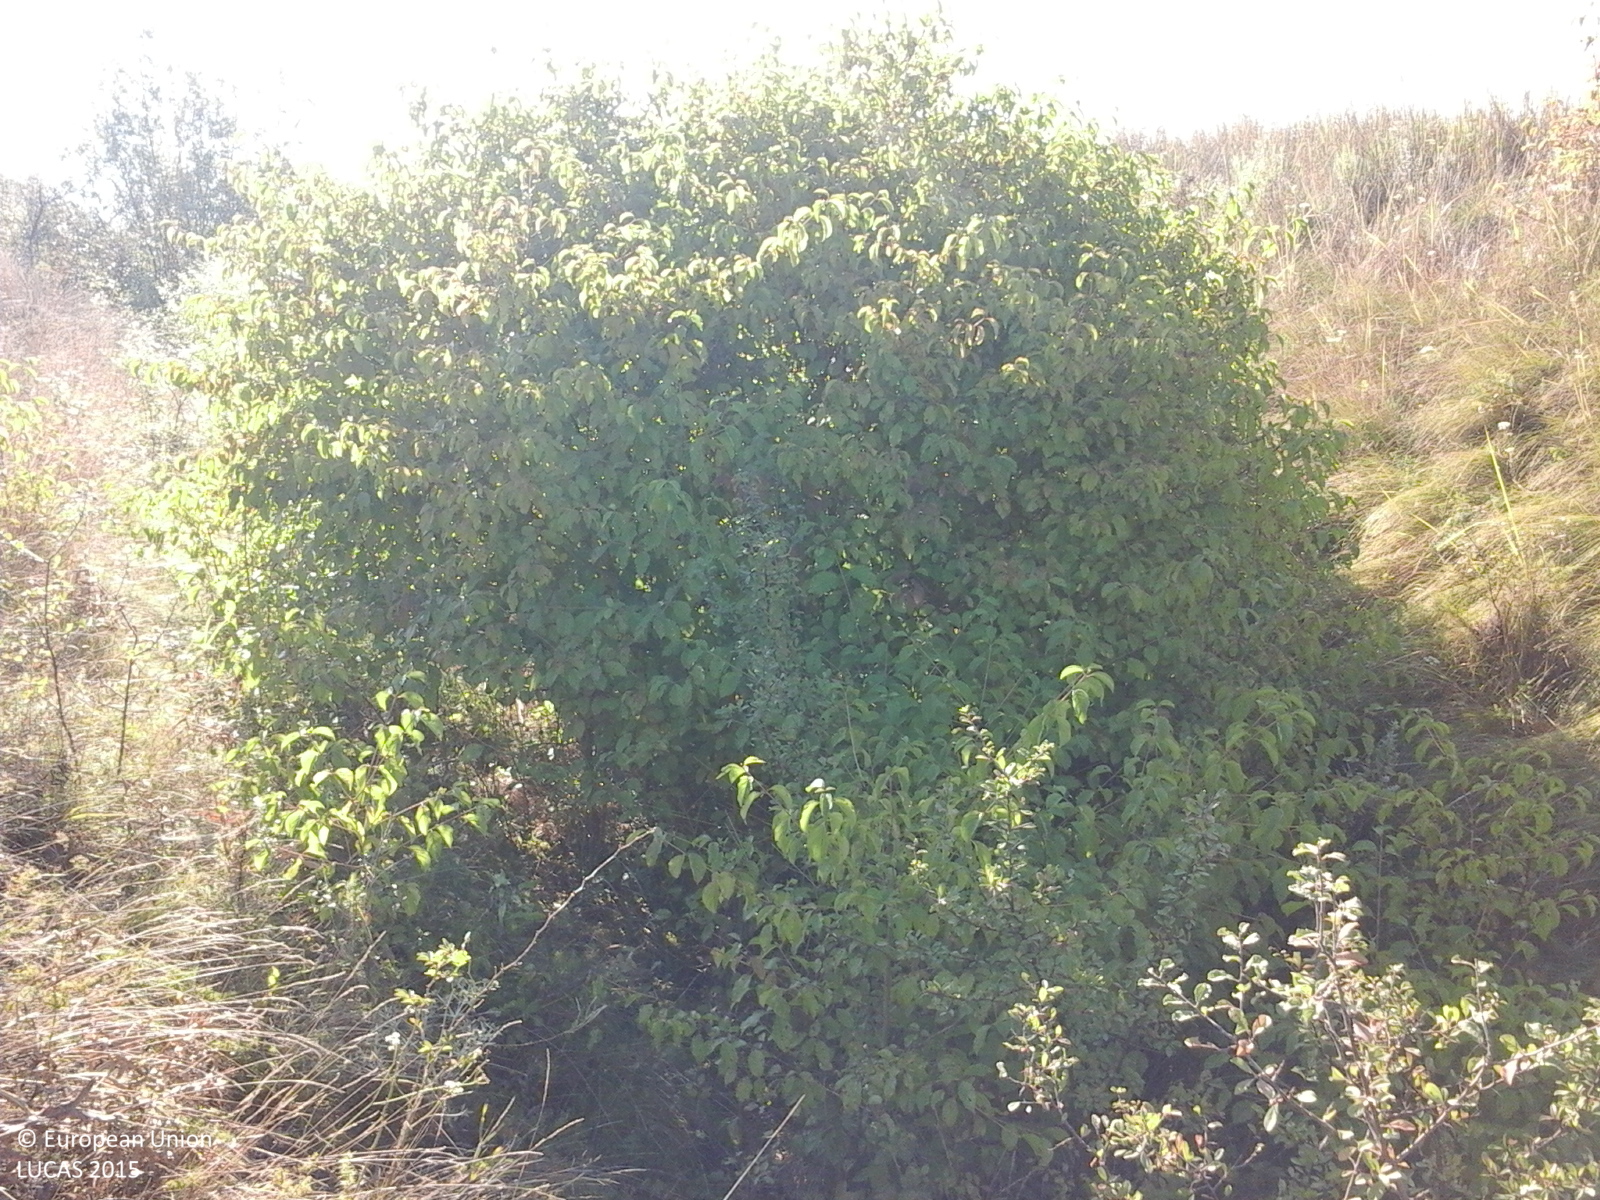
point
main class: Grassland
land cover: Spontaneously vegetated surfaces
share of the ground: > 75 %
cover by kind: herbaceous plants 100 %
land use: Semi-natural and natural areas not in use
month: August
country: RO
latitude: 45.6965
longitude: 21.2938
